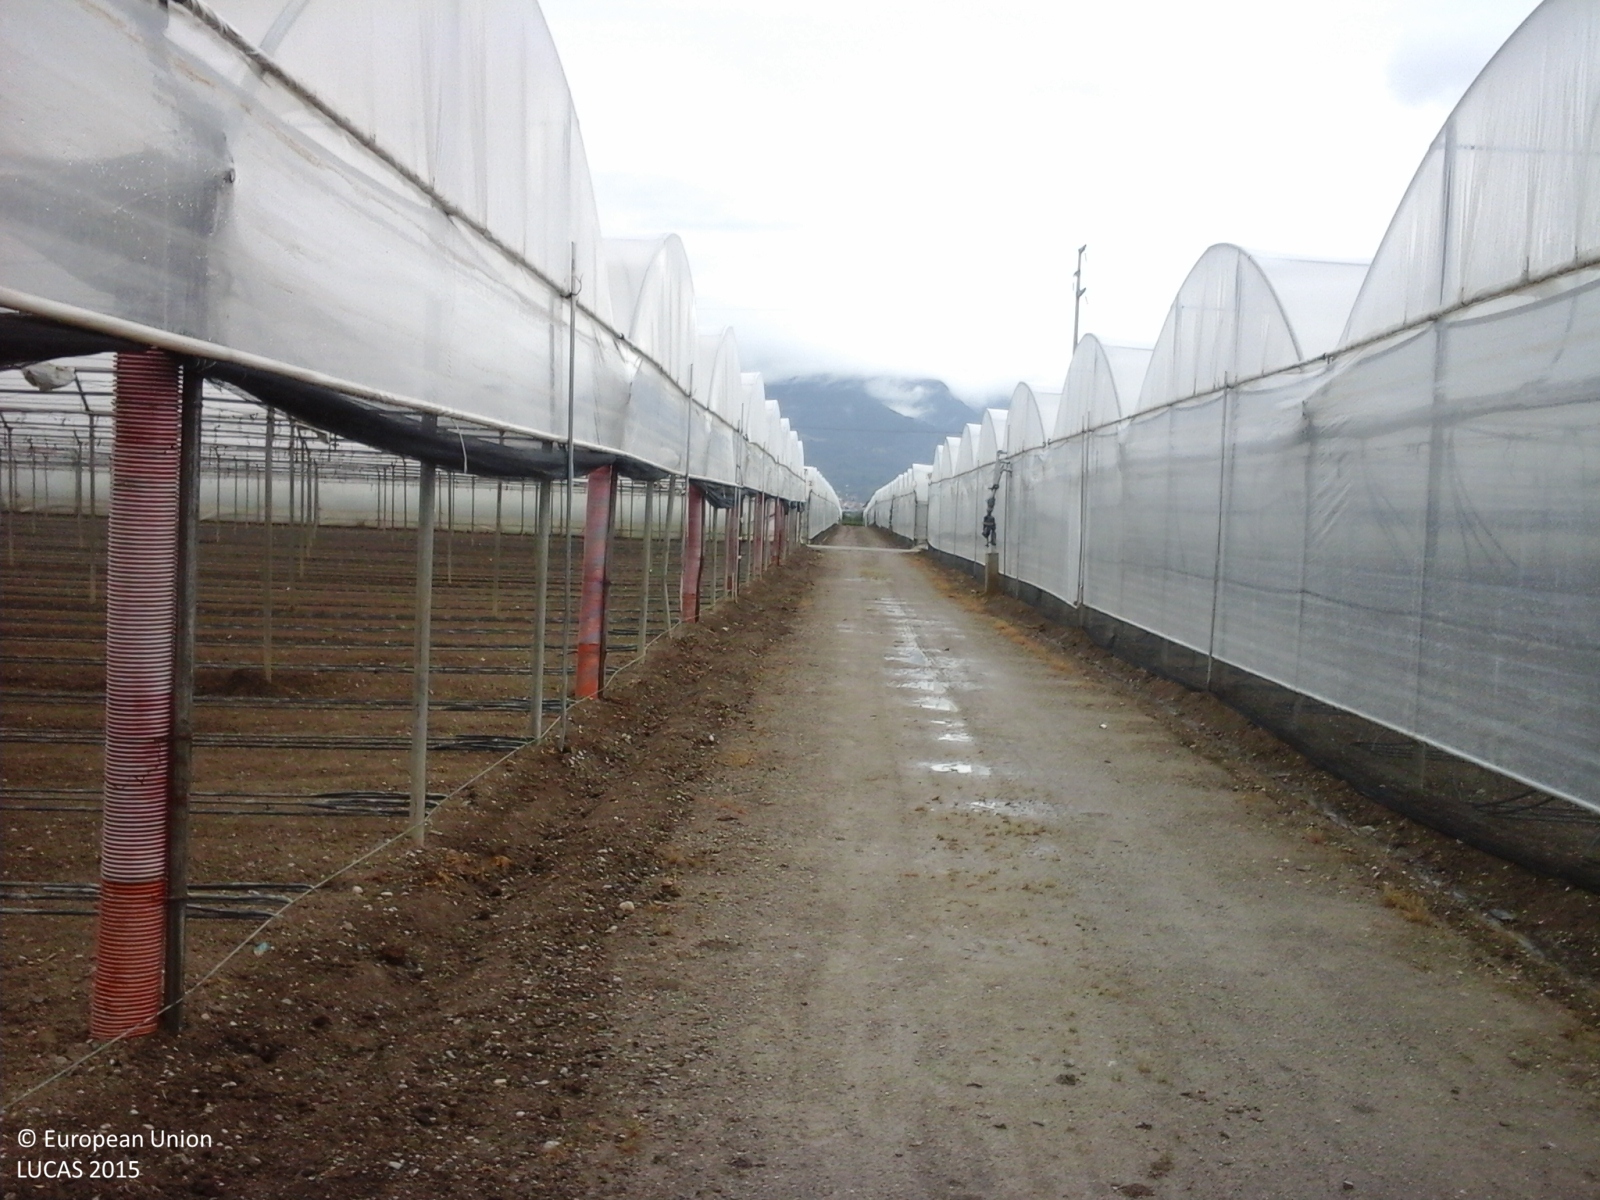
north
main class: Artificial land
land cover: Greenhouses
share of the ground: > 75 %
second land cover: Other fresh vegetables
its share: > 75 %
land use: Agriculture (excluding fallow land and kitchen gardens)
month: May
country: IT
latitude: 40.5725
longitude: 15.0465
